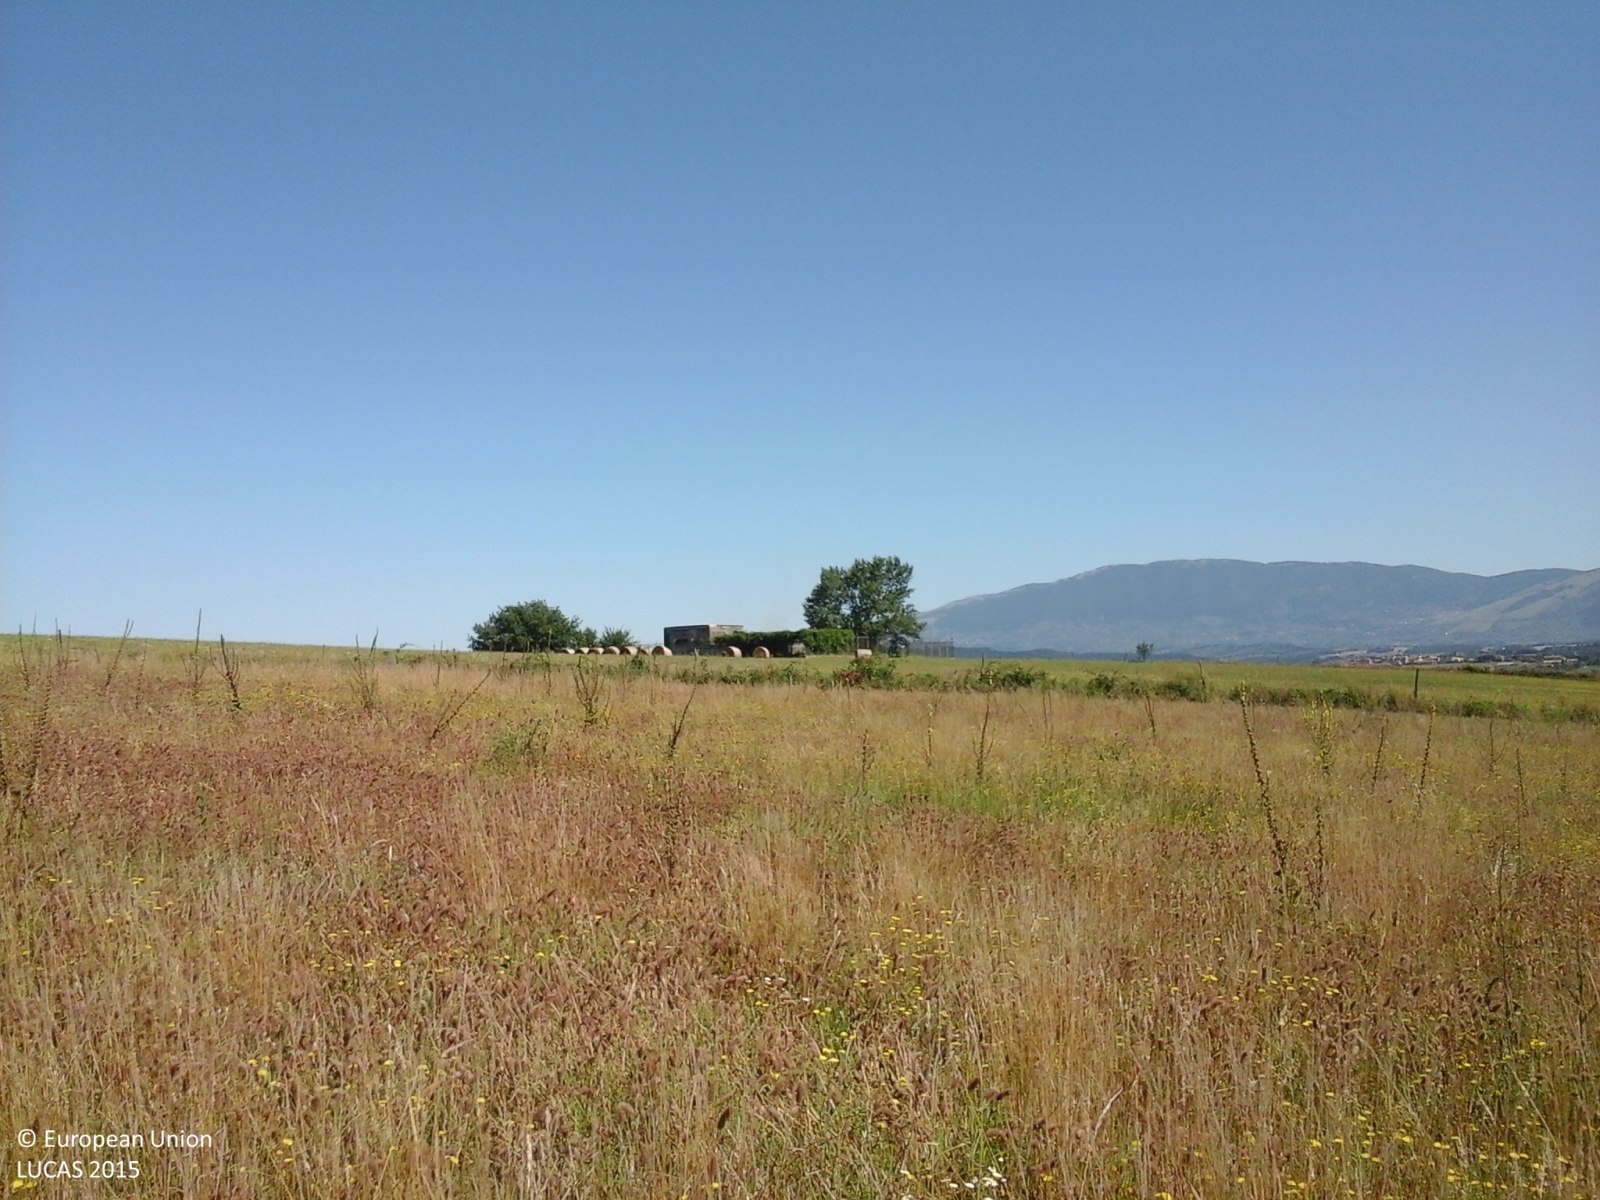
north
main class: Grassland
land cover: Grassland without tree/shrub cover
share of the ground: > 75 %
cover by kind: herbaceous plants 100 %
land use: Agriculture (excluding fallow land and kitchen gardens)
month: June
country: IT
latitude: 41.7033
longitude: 13.0768
